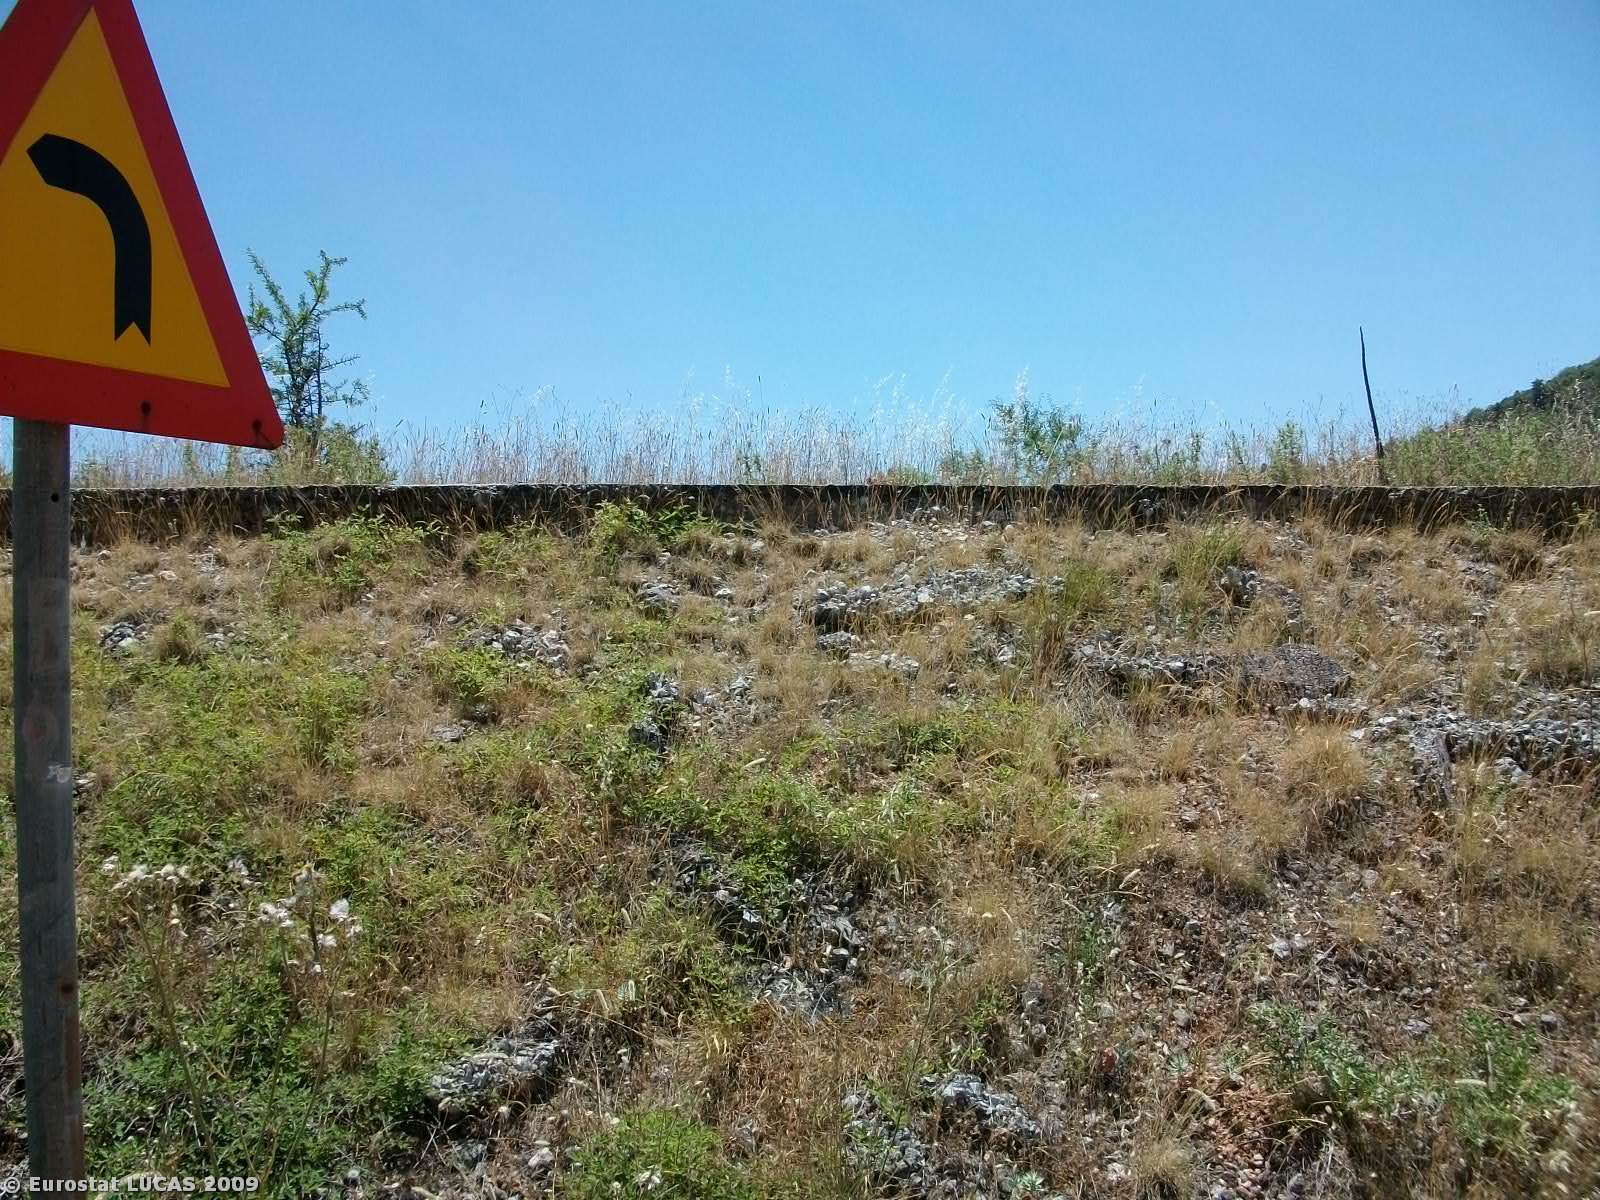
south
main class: Grassland
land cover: Grassland without tree/shrub cover
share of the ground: 25 - 50 %
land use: Fallow land
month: June
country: GR
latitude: 37.3525
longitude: 22.4120
